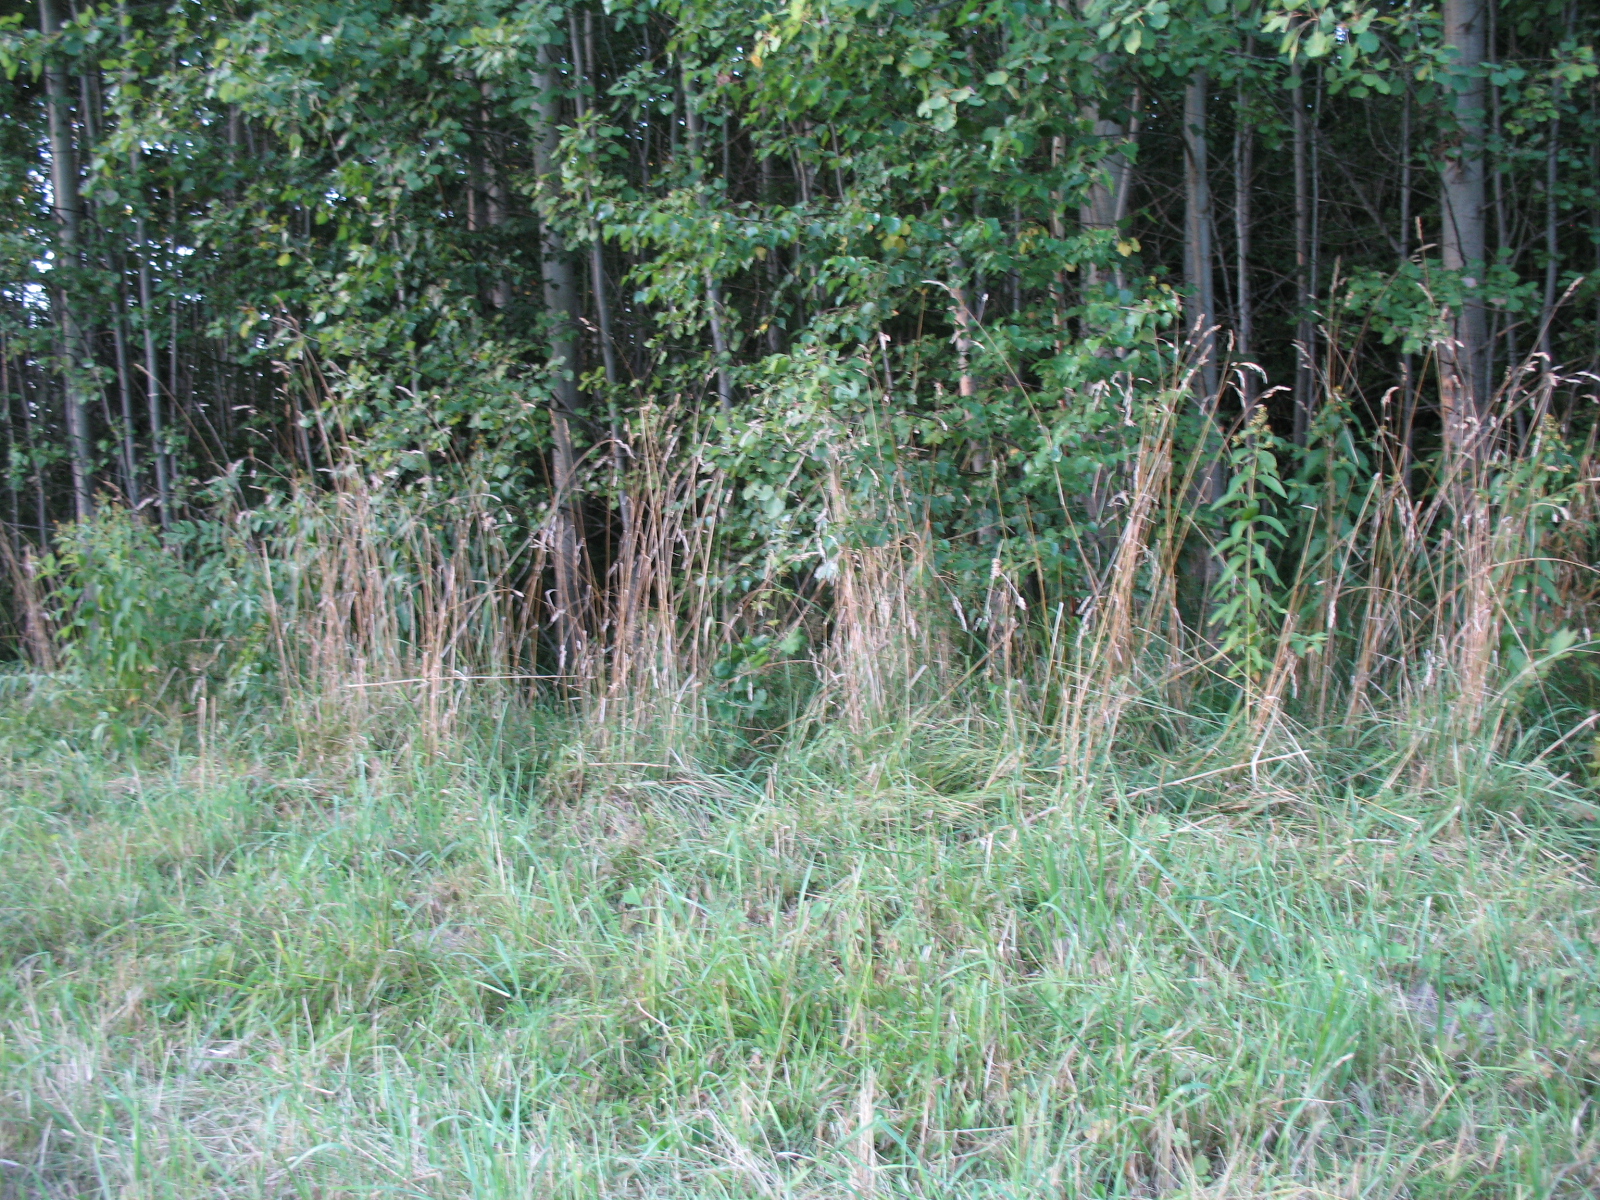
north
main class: Grassland
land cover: Grassland without tree/shrub cover
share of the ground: > 75 %
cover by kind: herbaceous plants 95 %, unconsolidated bare surface 5 %
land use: Agriculture (excluding fallow land and kitchen gardens)
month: August
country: LV
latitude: 56.5925
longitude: 25.6765
